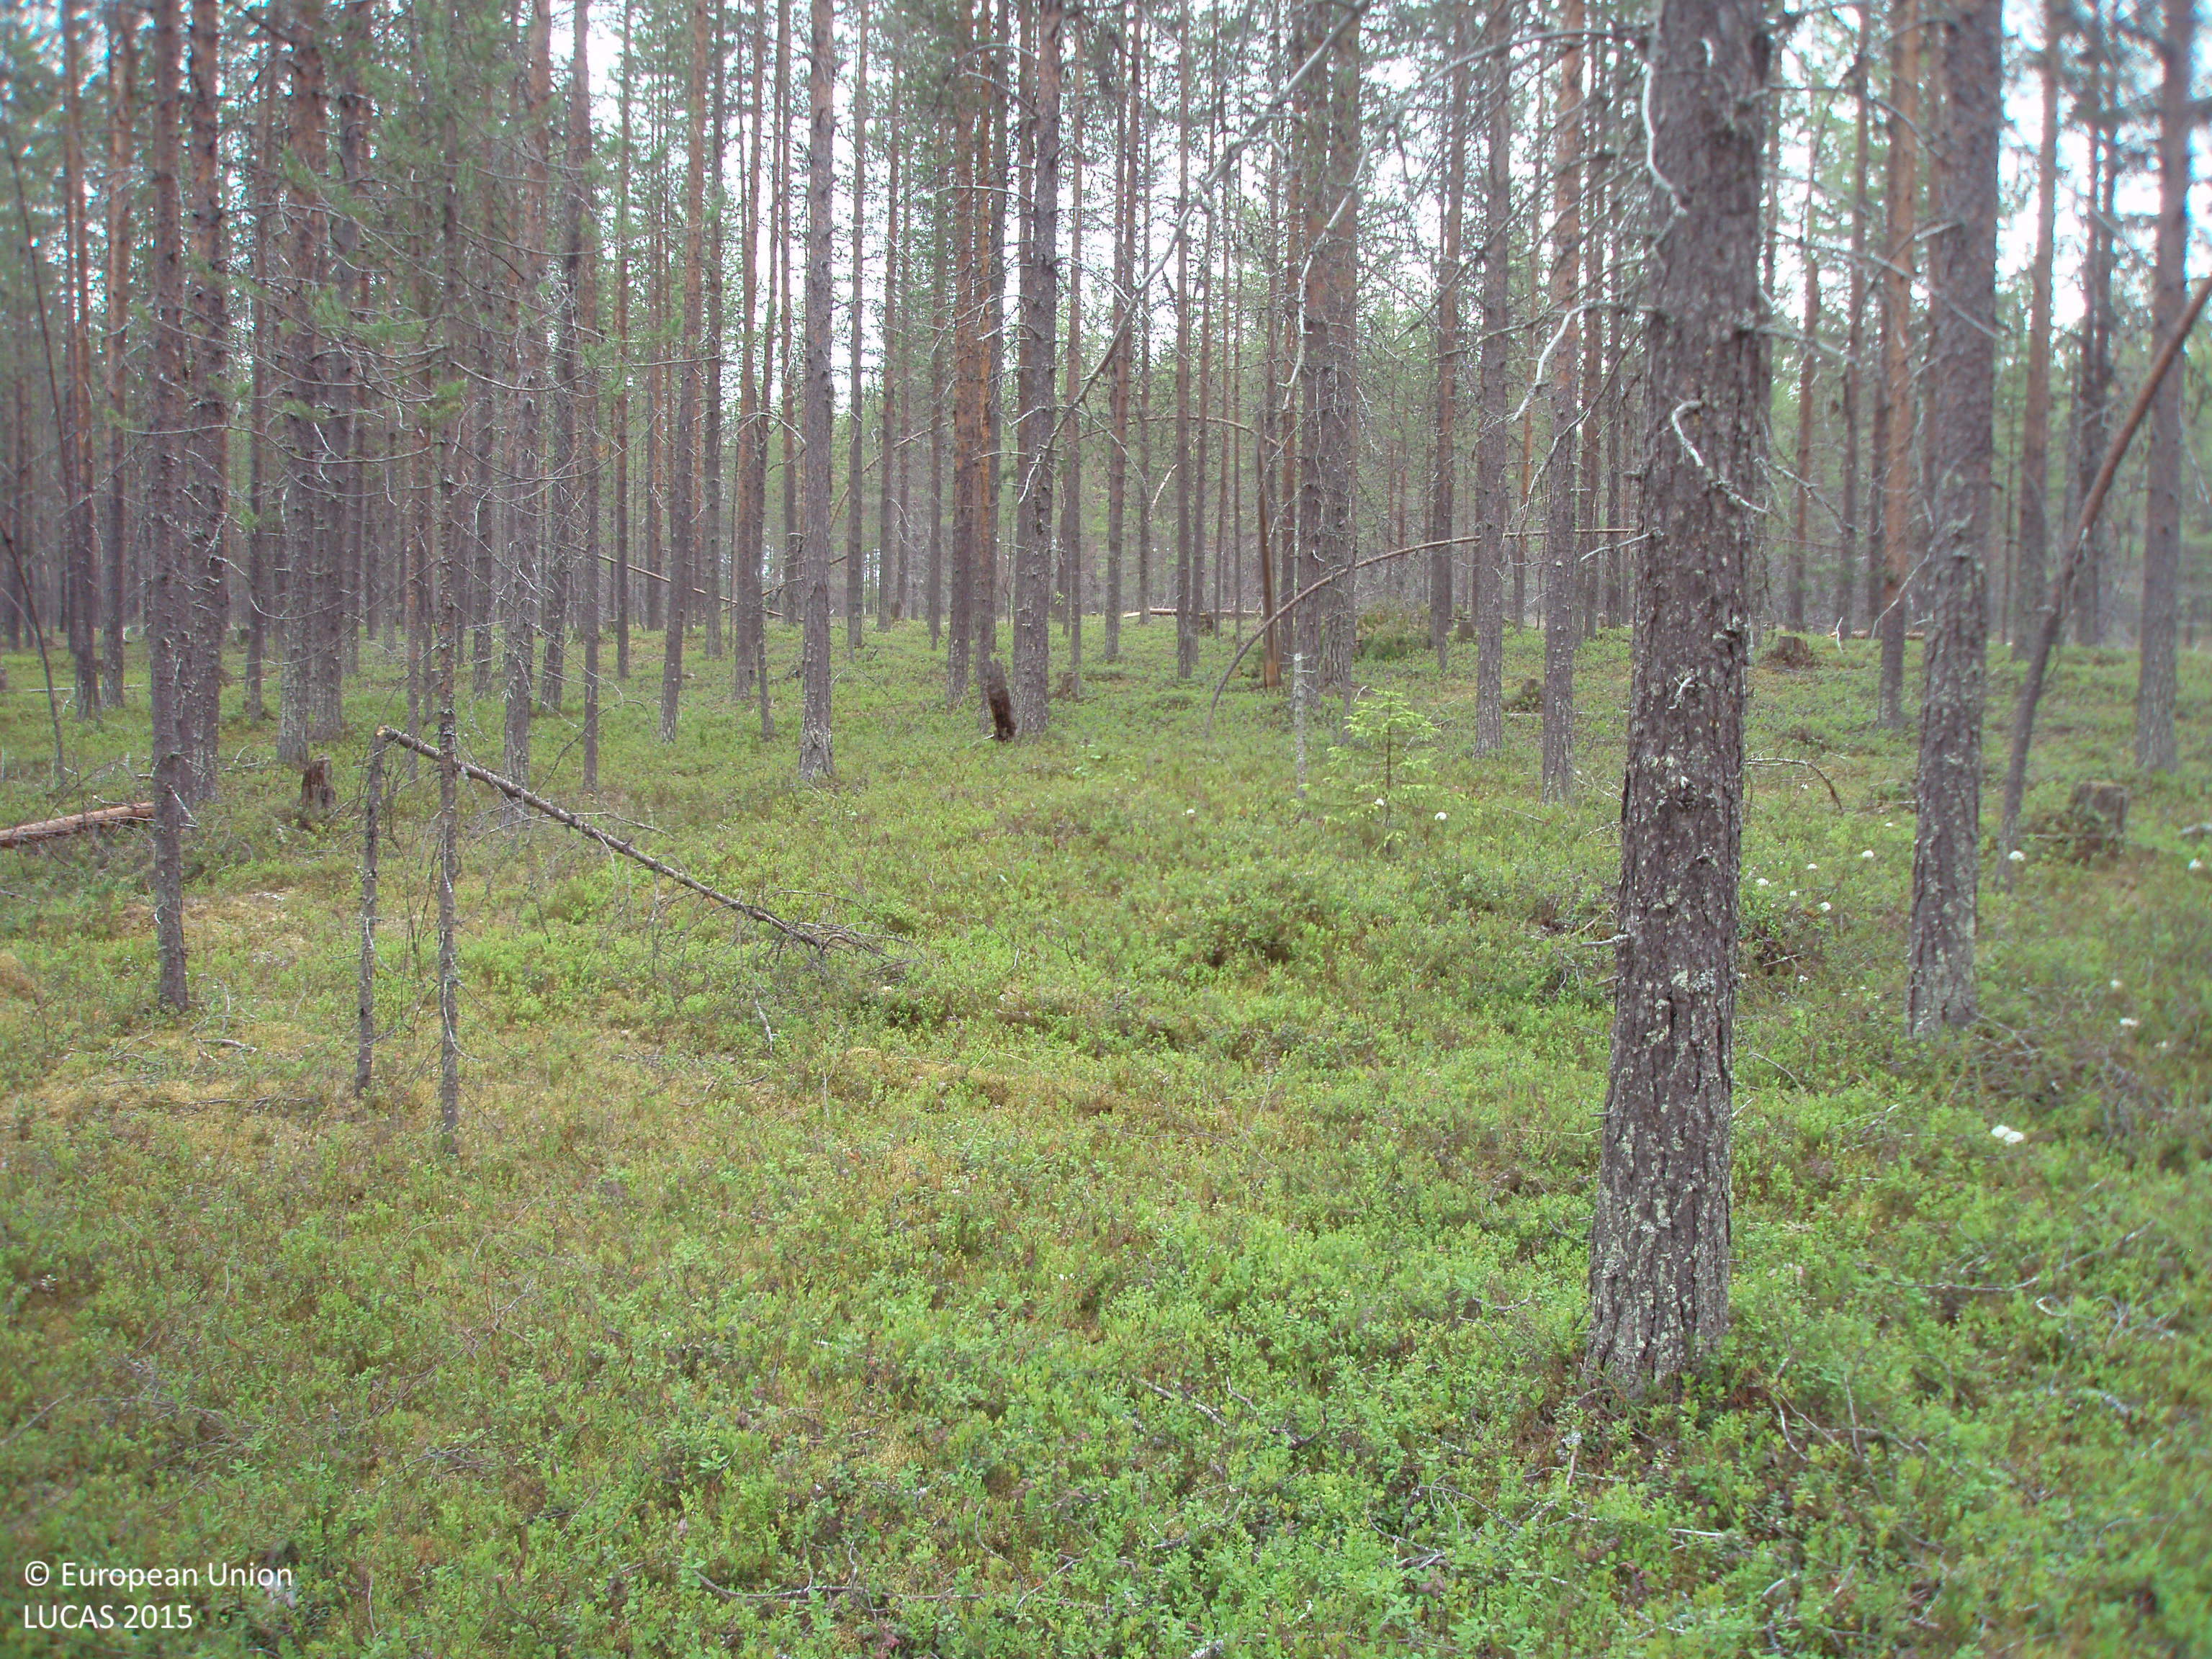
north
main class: Woodland
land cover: Pine dominated coniferous woodland
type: boreal forest
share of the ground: > 75 %
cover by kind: coniferous forest trees 75 %, shrubs 25 %
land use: Forestry
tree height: > 5 m
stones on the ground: < 10 %
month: July
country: FI
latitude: 67.3108
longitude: 28.2202
